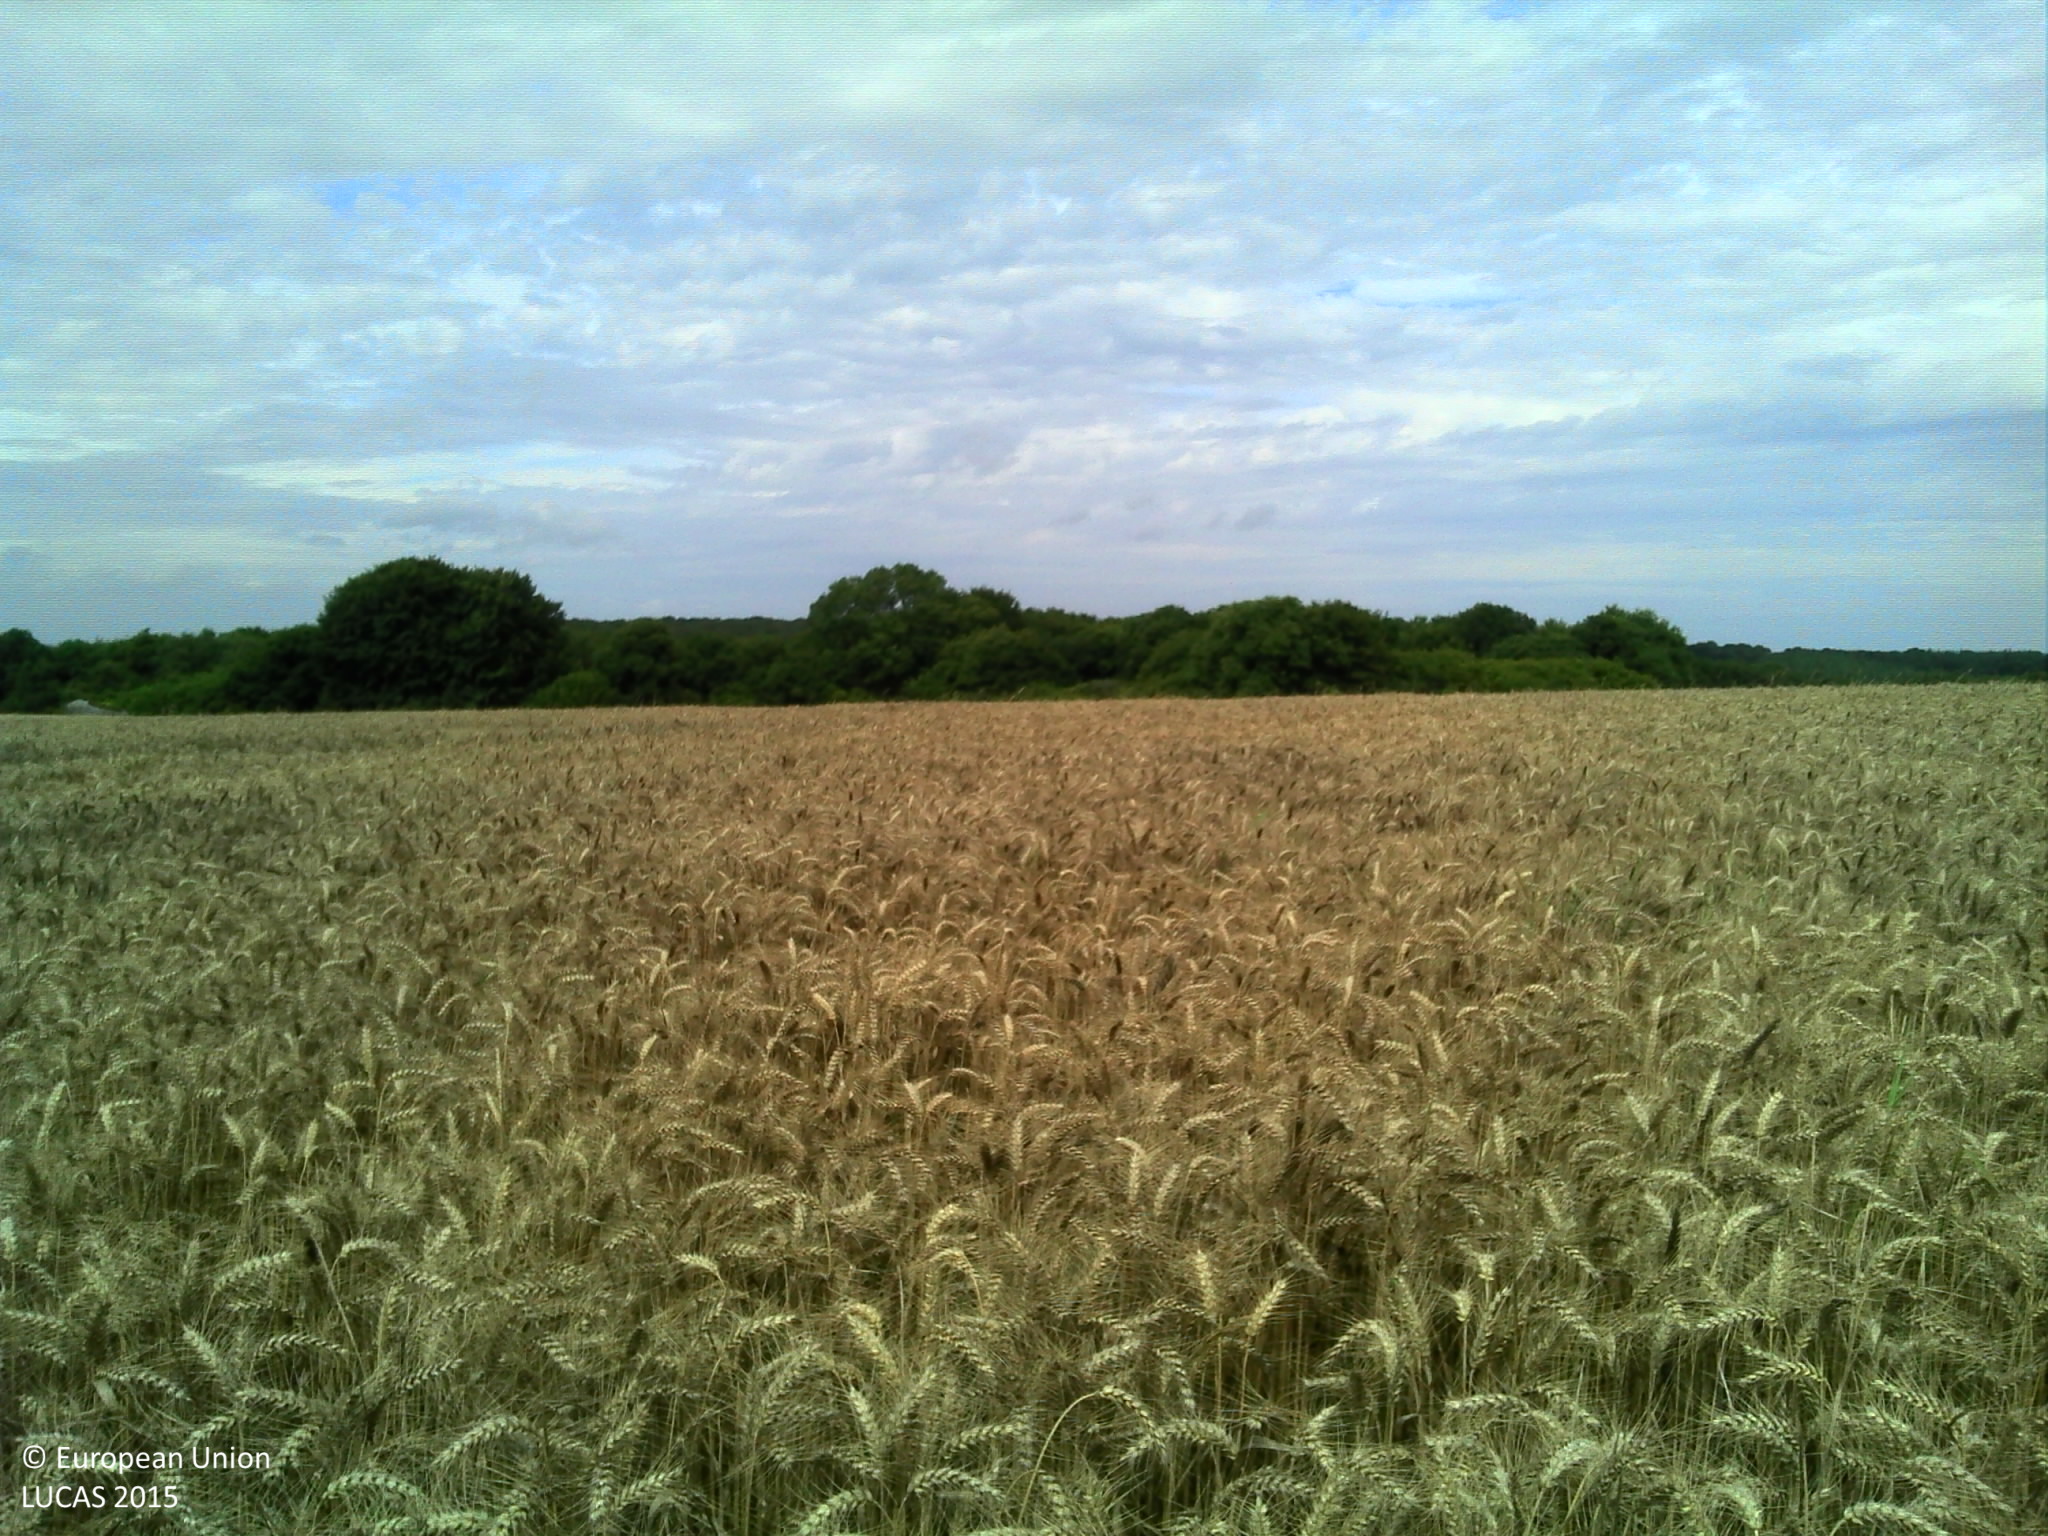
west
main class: Cropland
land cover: Common wheat
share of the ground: > 75 %
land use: Agriculture (excluding fallow land and kitchen gardens)
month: August
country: FR
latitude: 48.3211
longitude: -3.3322
